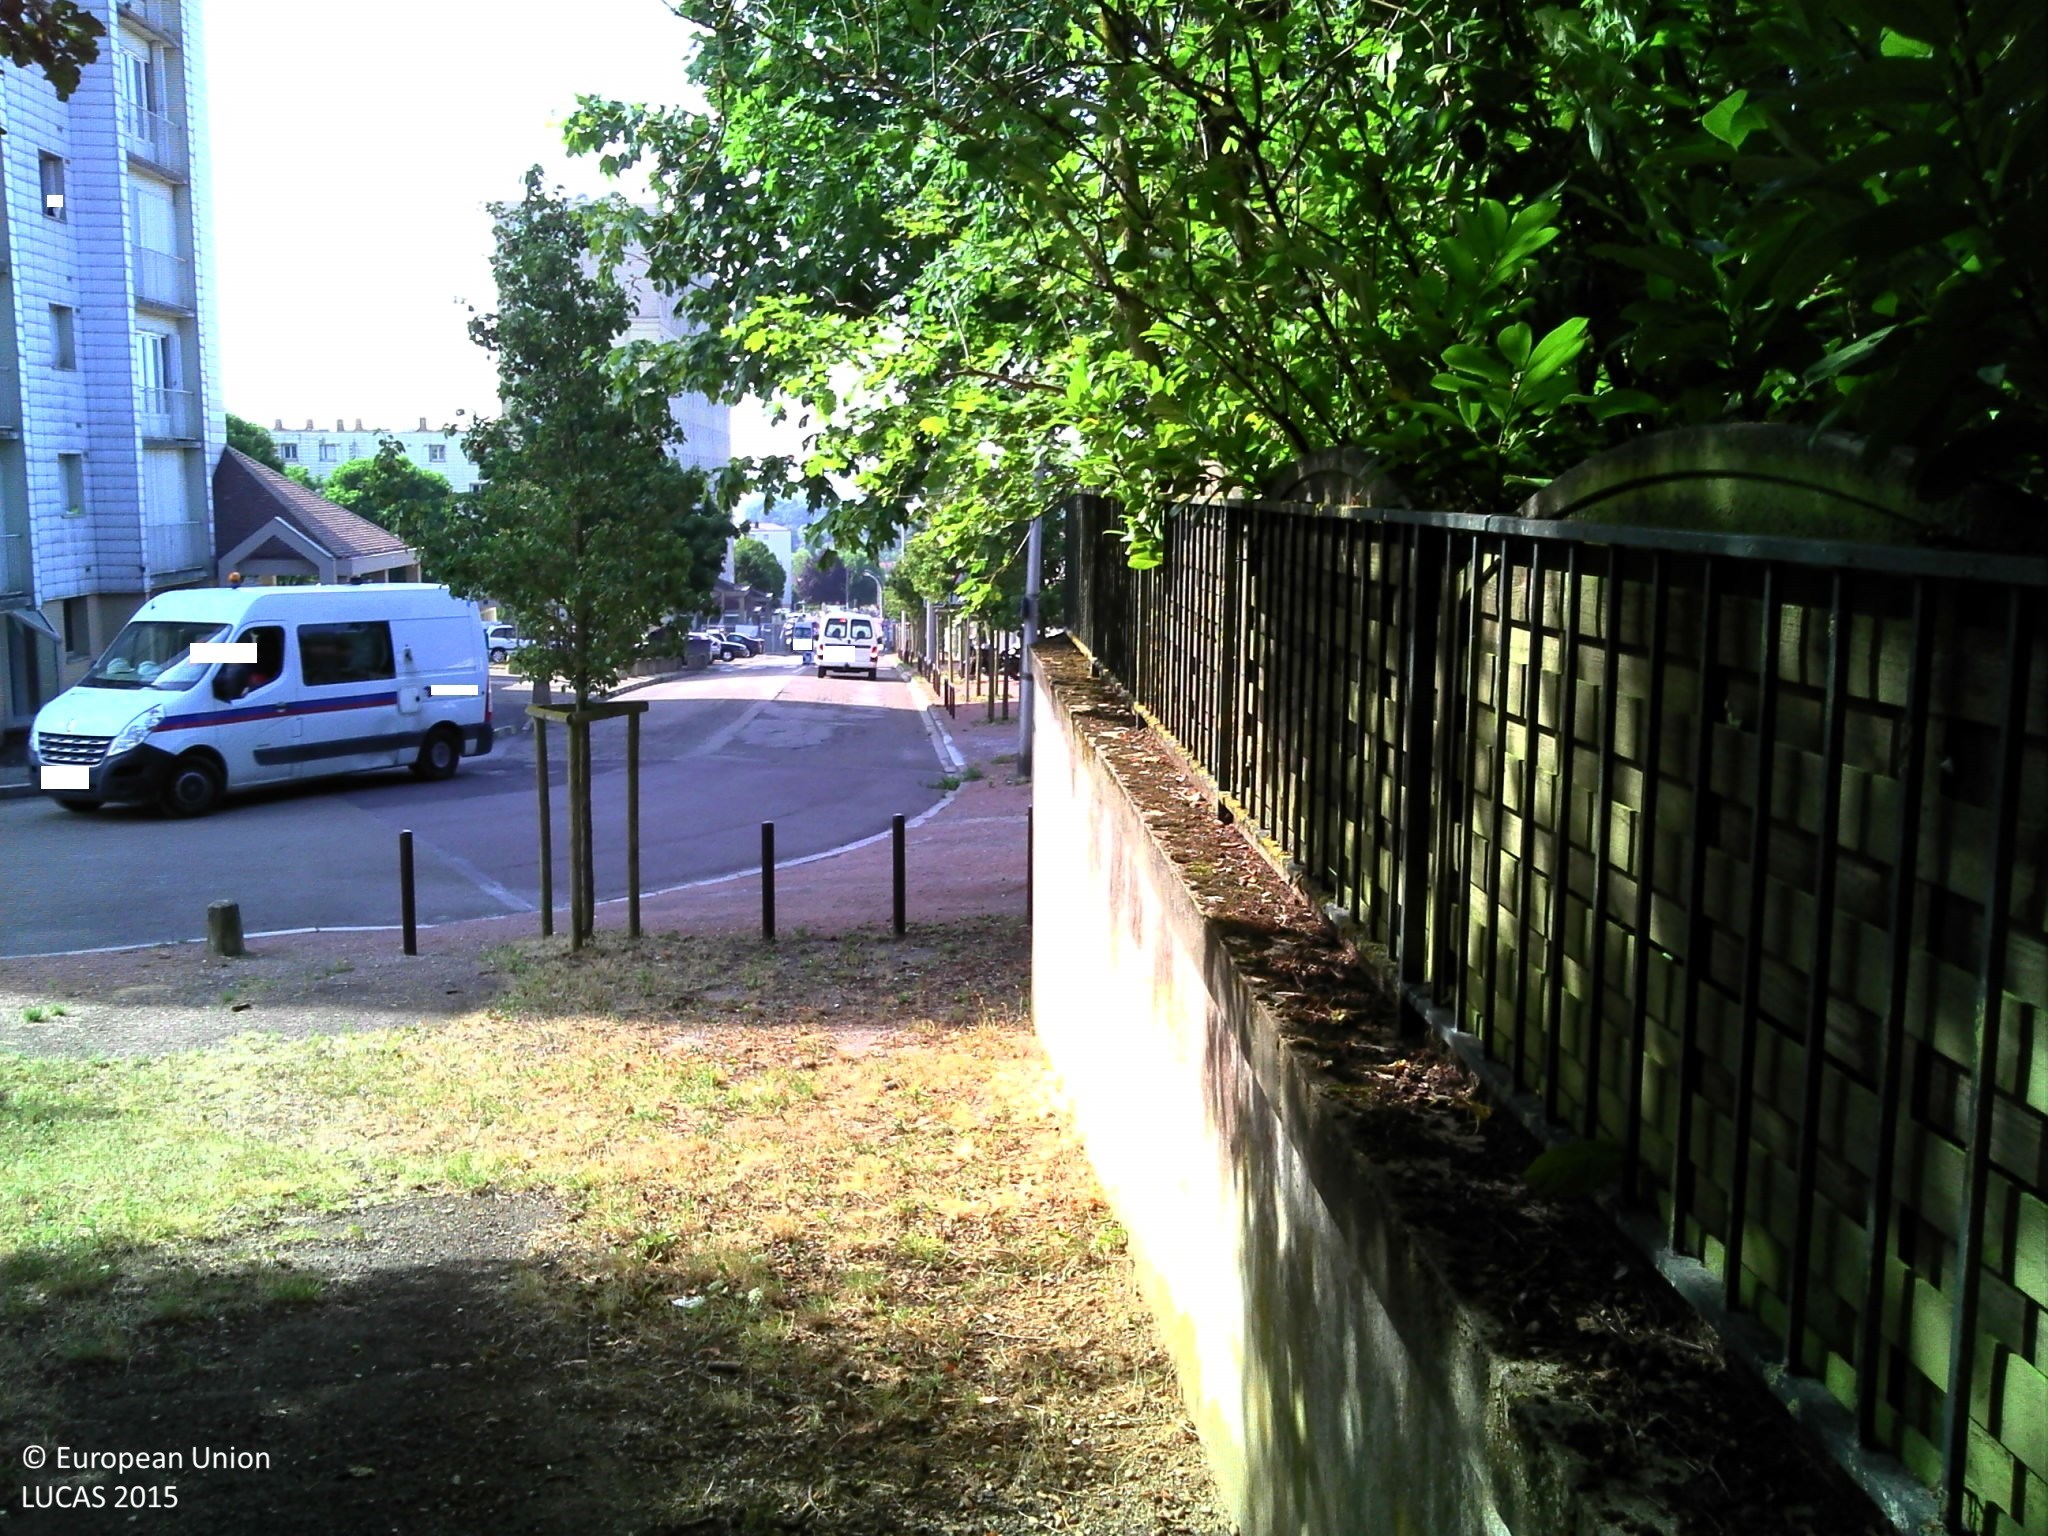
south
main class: Grassland
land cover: Grassland with sparse tree/shrub cover
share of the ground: > 75 %
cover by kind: herbaceous plants 95 %, broadleaved forest trees 5 %
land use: Amenities, museums, leisure
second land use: Residential
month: August
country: FR
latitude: 47.7998
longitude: 3.5470
